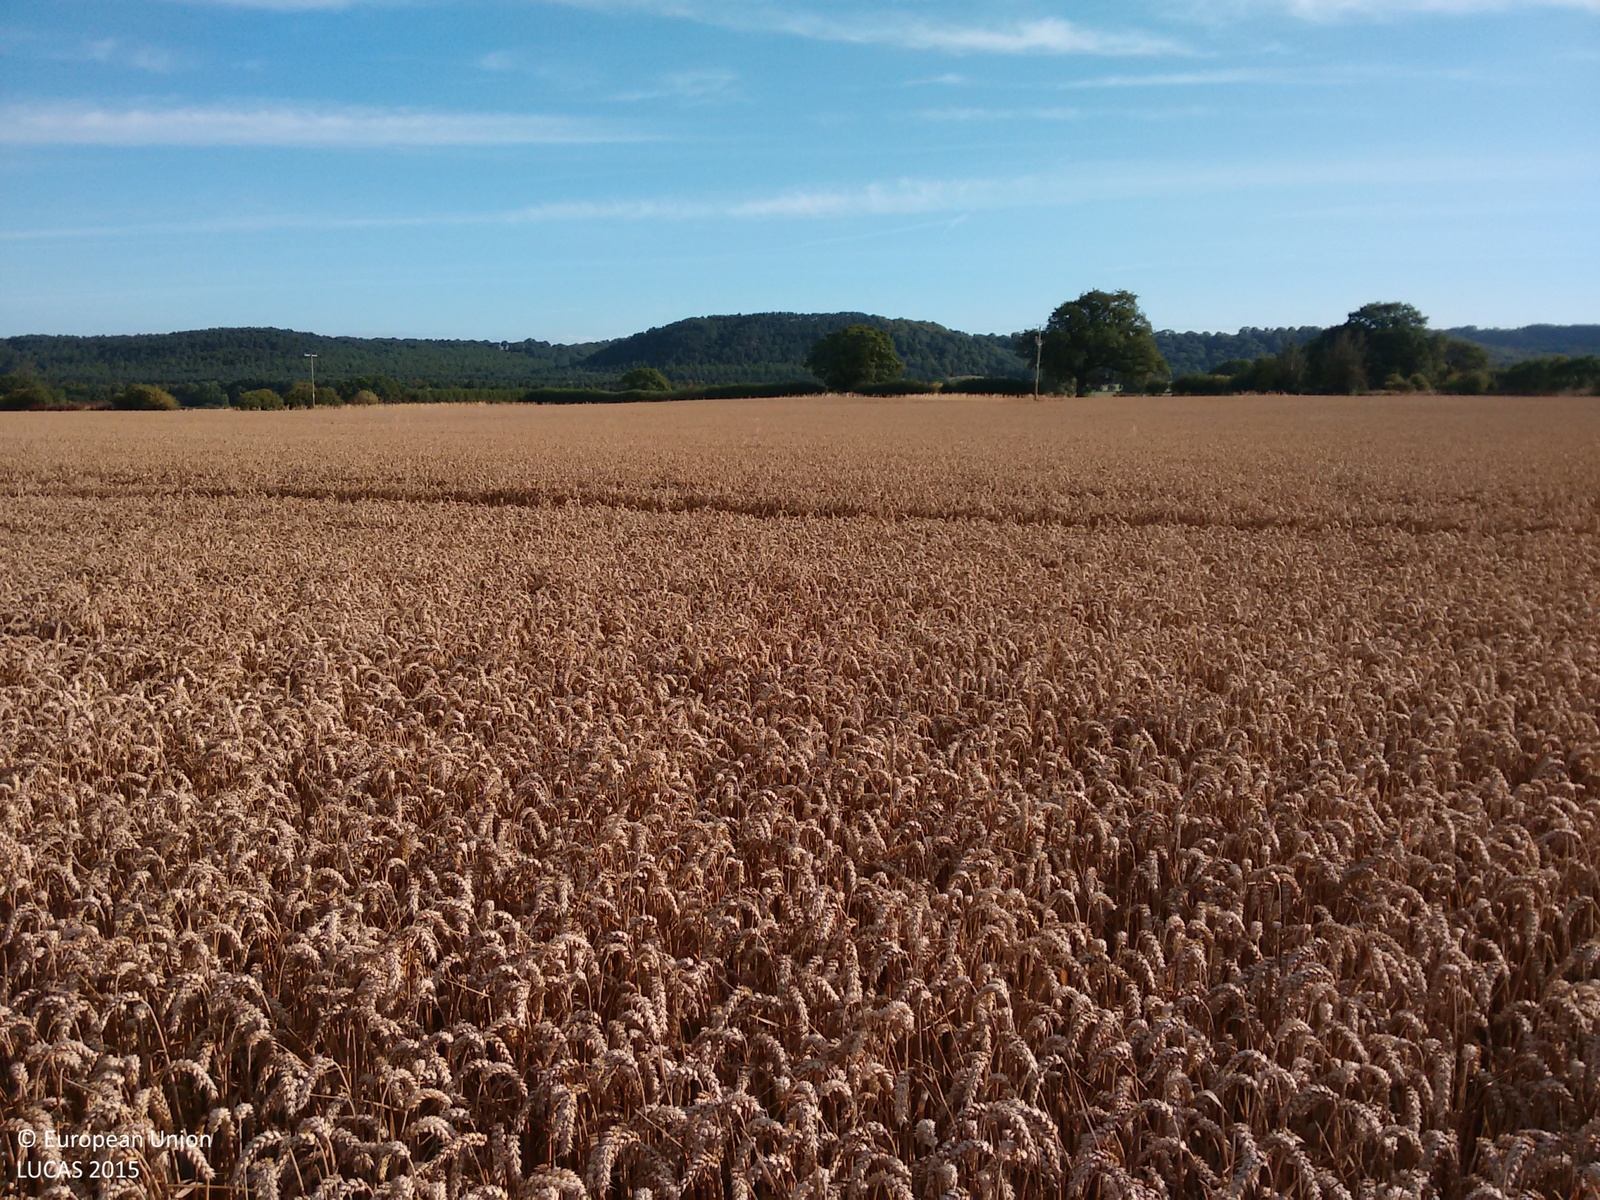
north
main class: Cropland
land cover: Common wheat
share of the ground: > 75 %
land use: Agriculture (excluding fallow land and kitchen gardens)
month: August
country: GB
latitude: 52.8274
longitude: -2.6391
